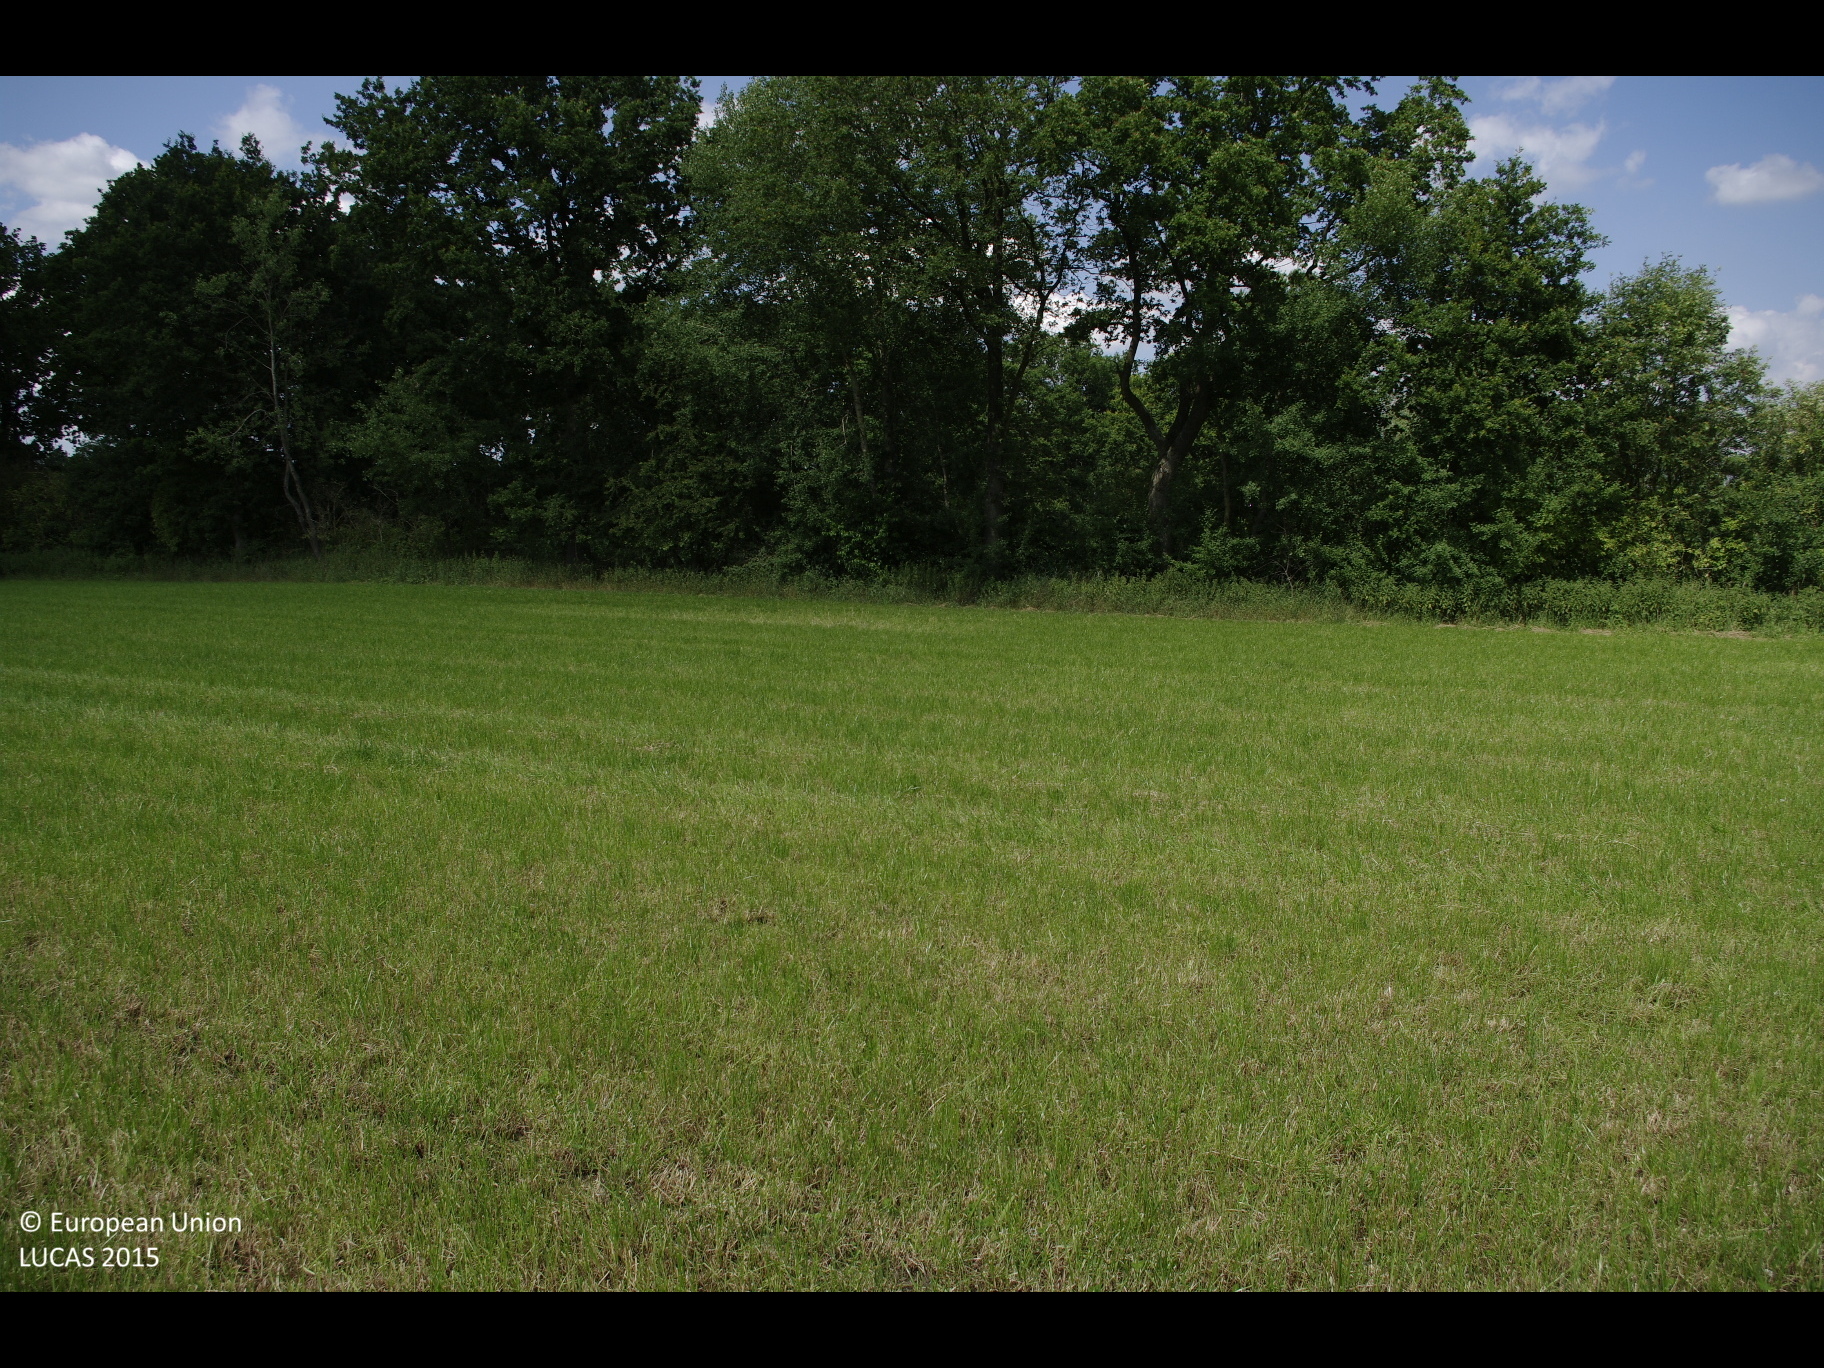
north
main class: Cropland
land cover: Temporary grasslands
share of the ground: > 75 %
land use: Agriculture (excluding fallow land and kitchen gardens)
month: July
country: DE
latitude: 53.8871
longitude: 9.8936
